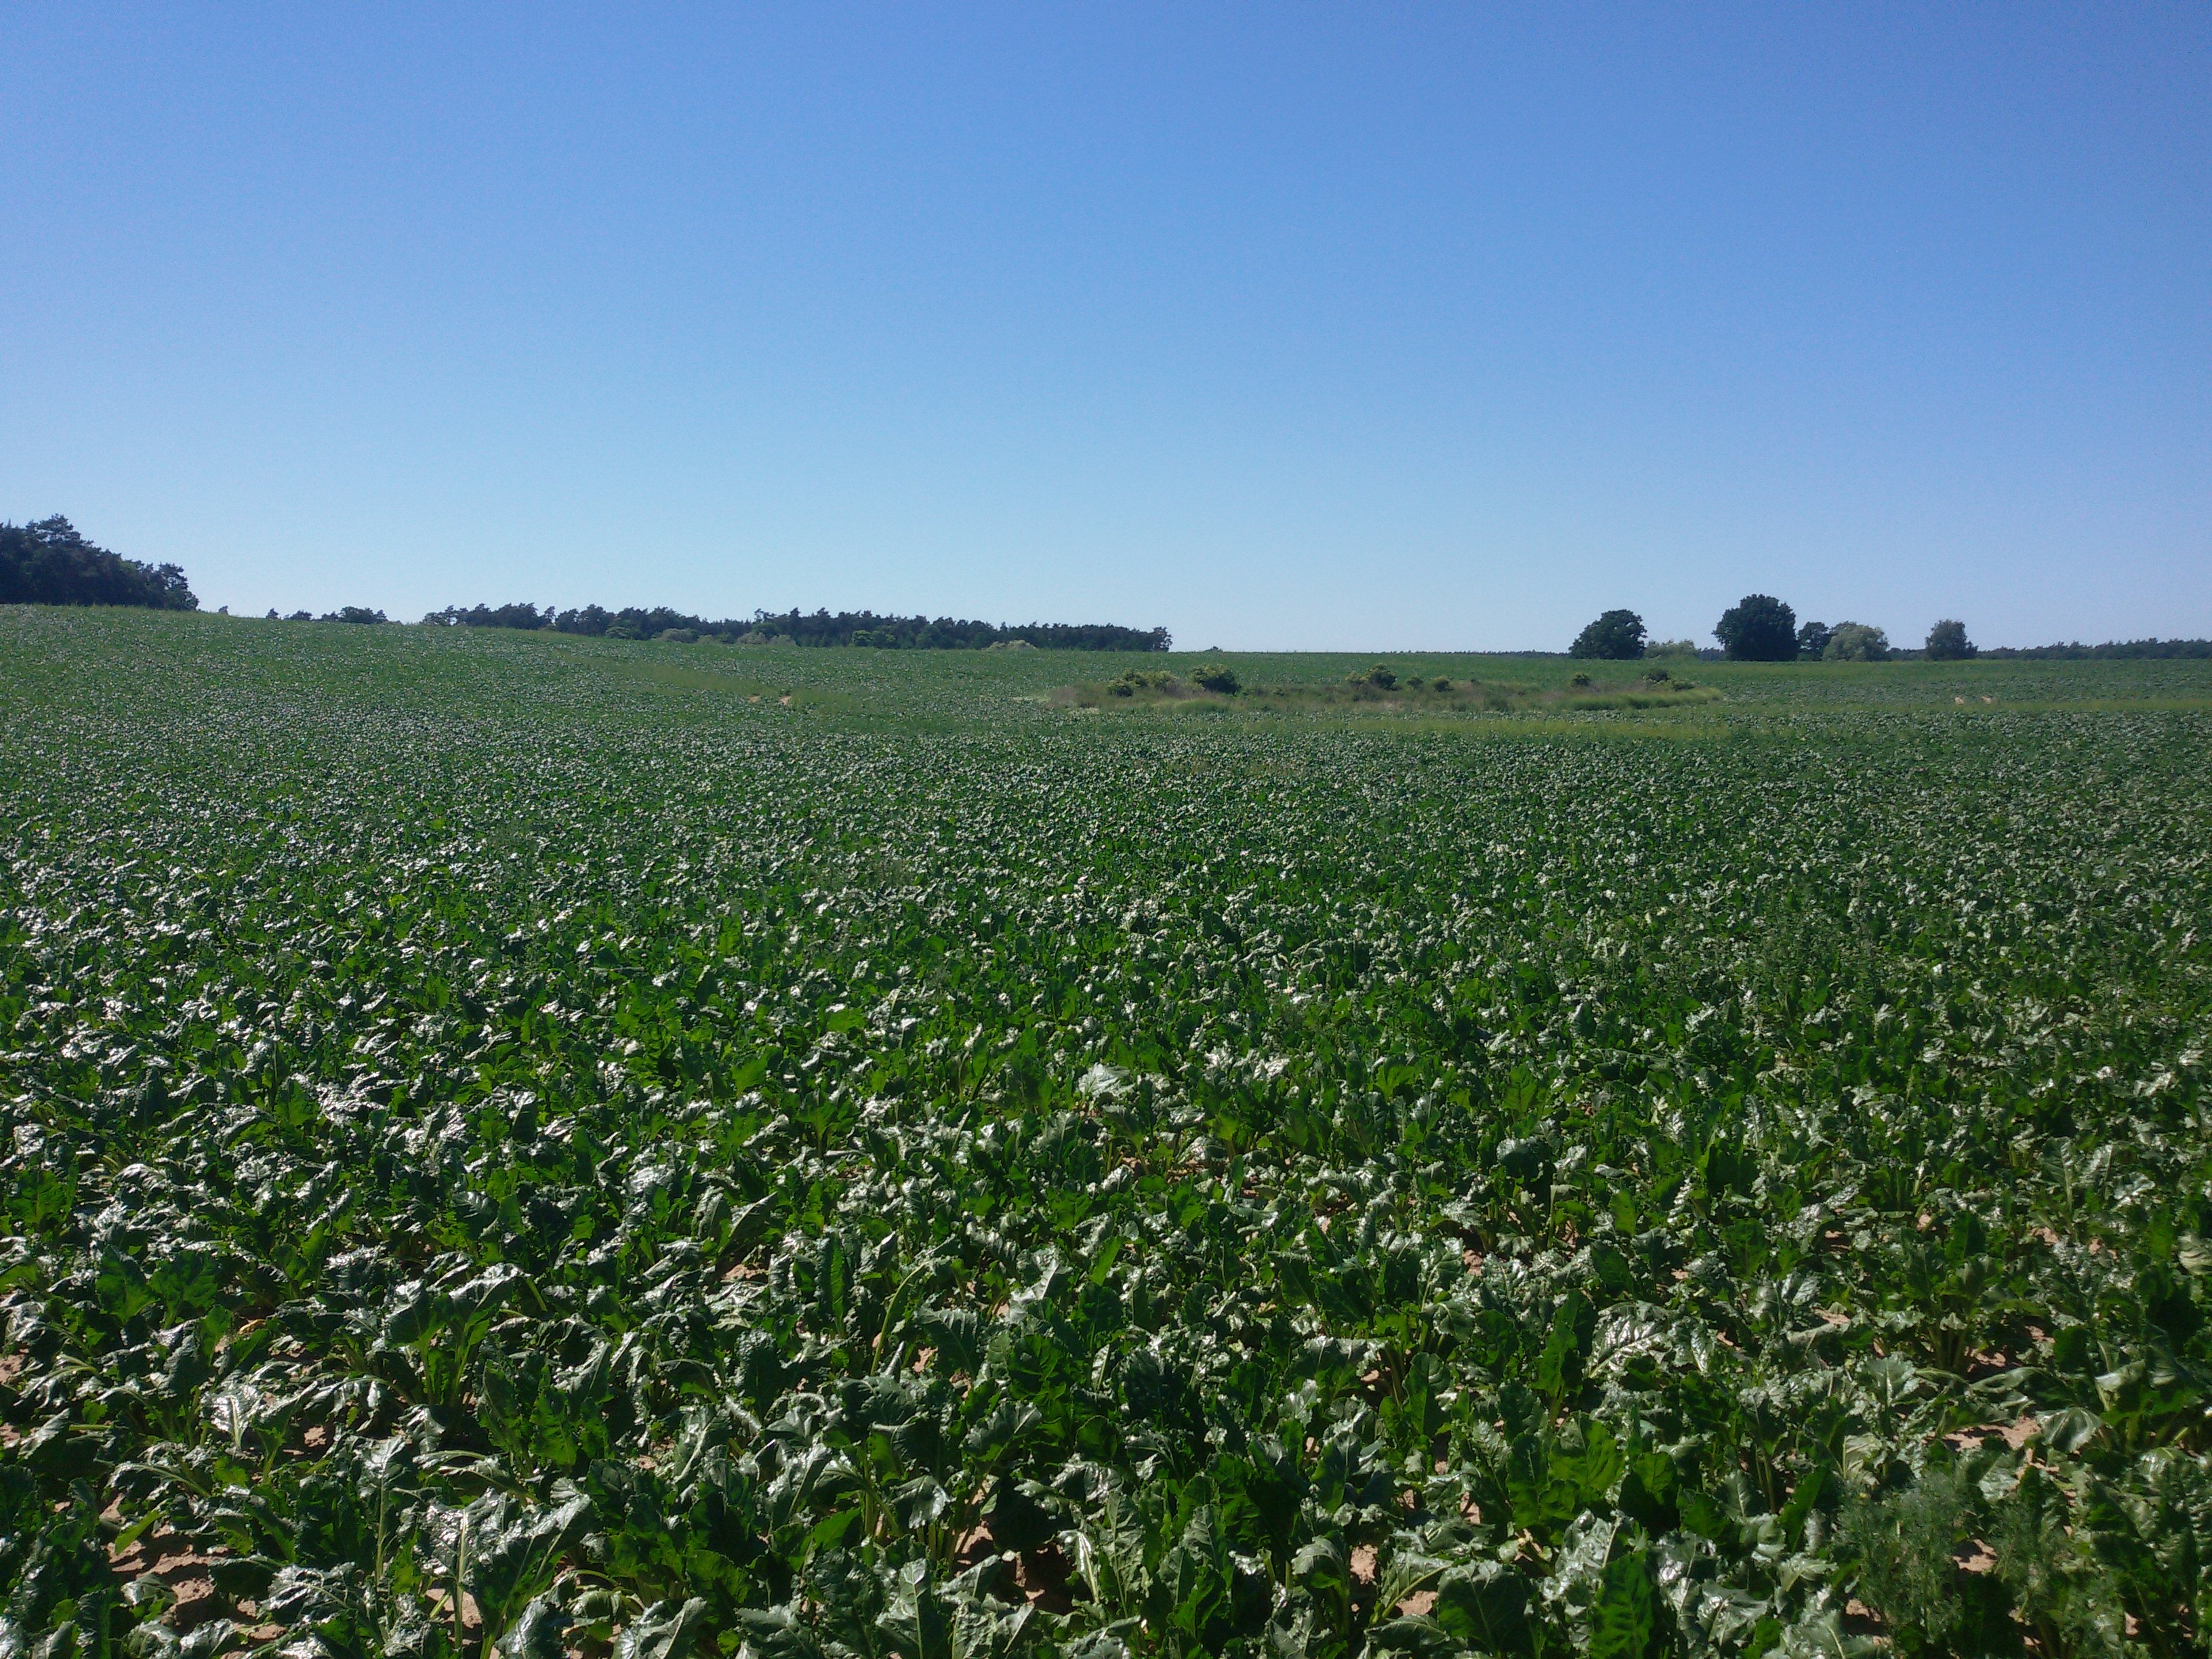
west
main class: Cropland
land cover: Sugar beet
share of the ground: > 75 %
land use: Agriculture (excluding fallow land and kitchen gardens)
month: July
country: PL
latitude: 53.1529
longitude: 14.5922
